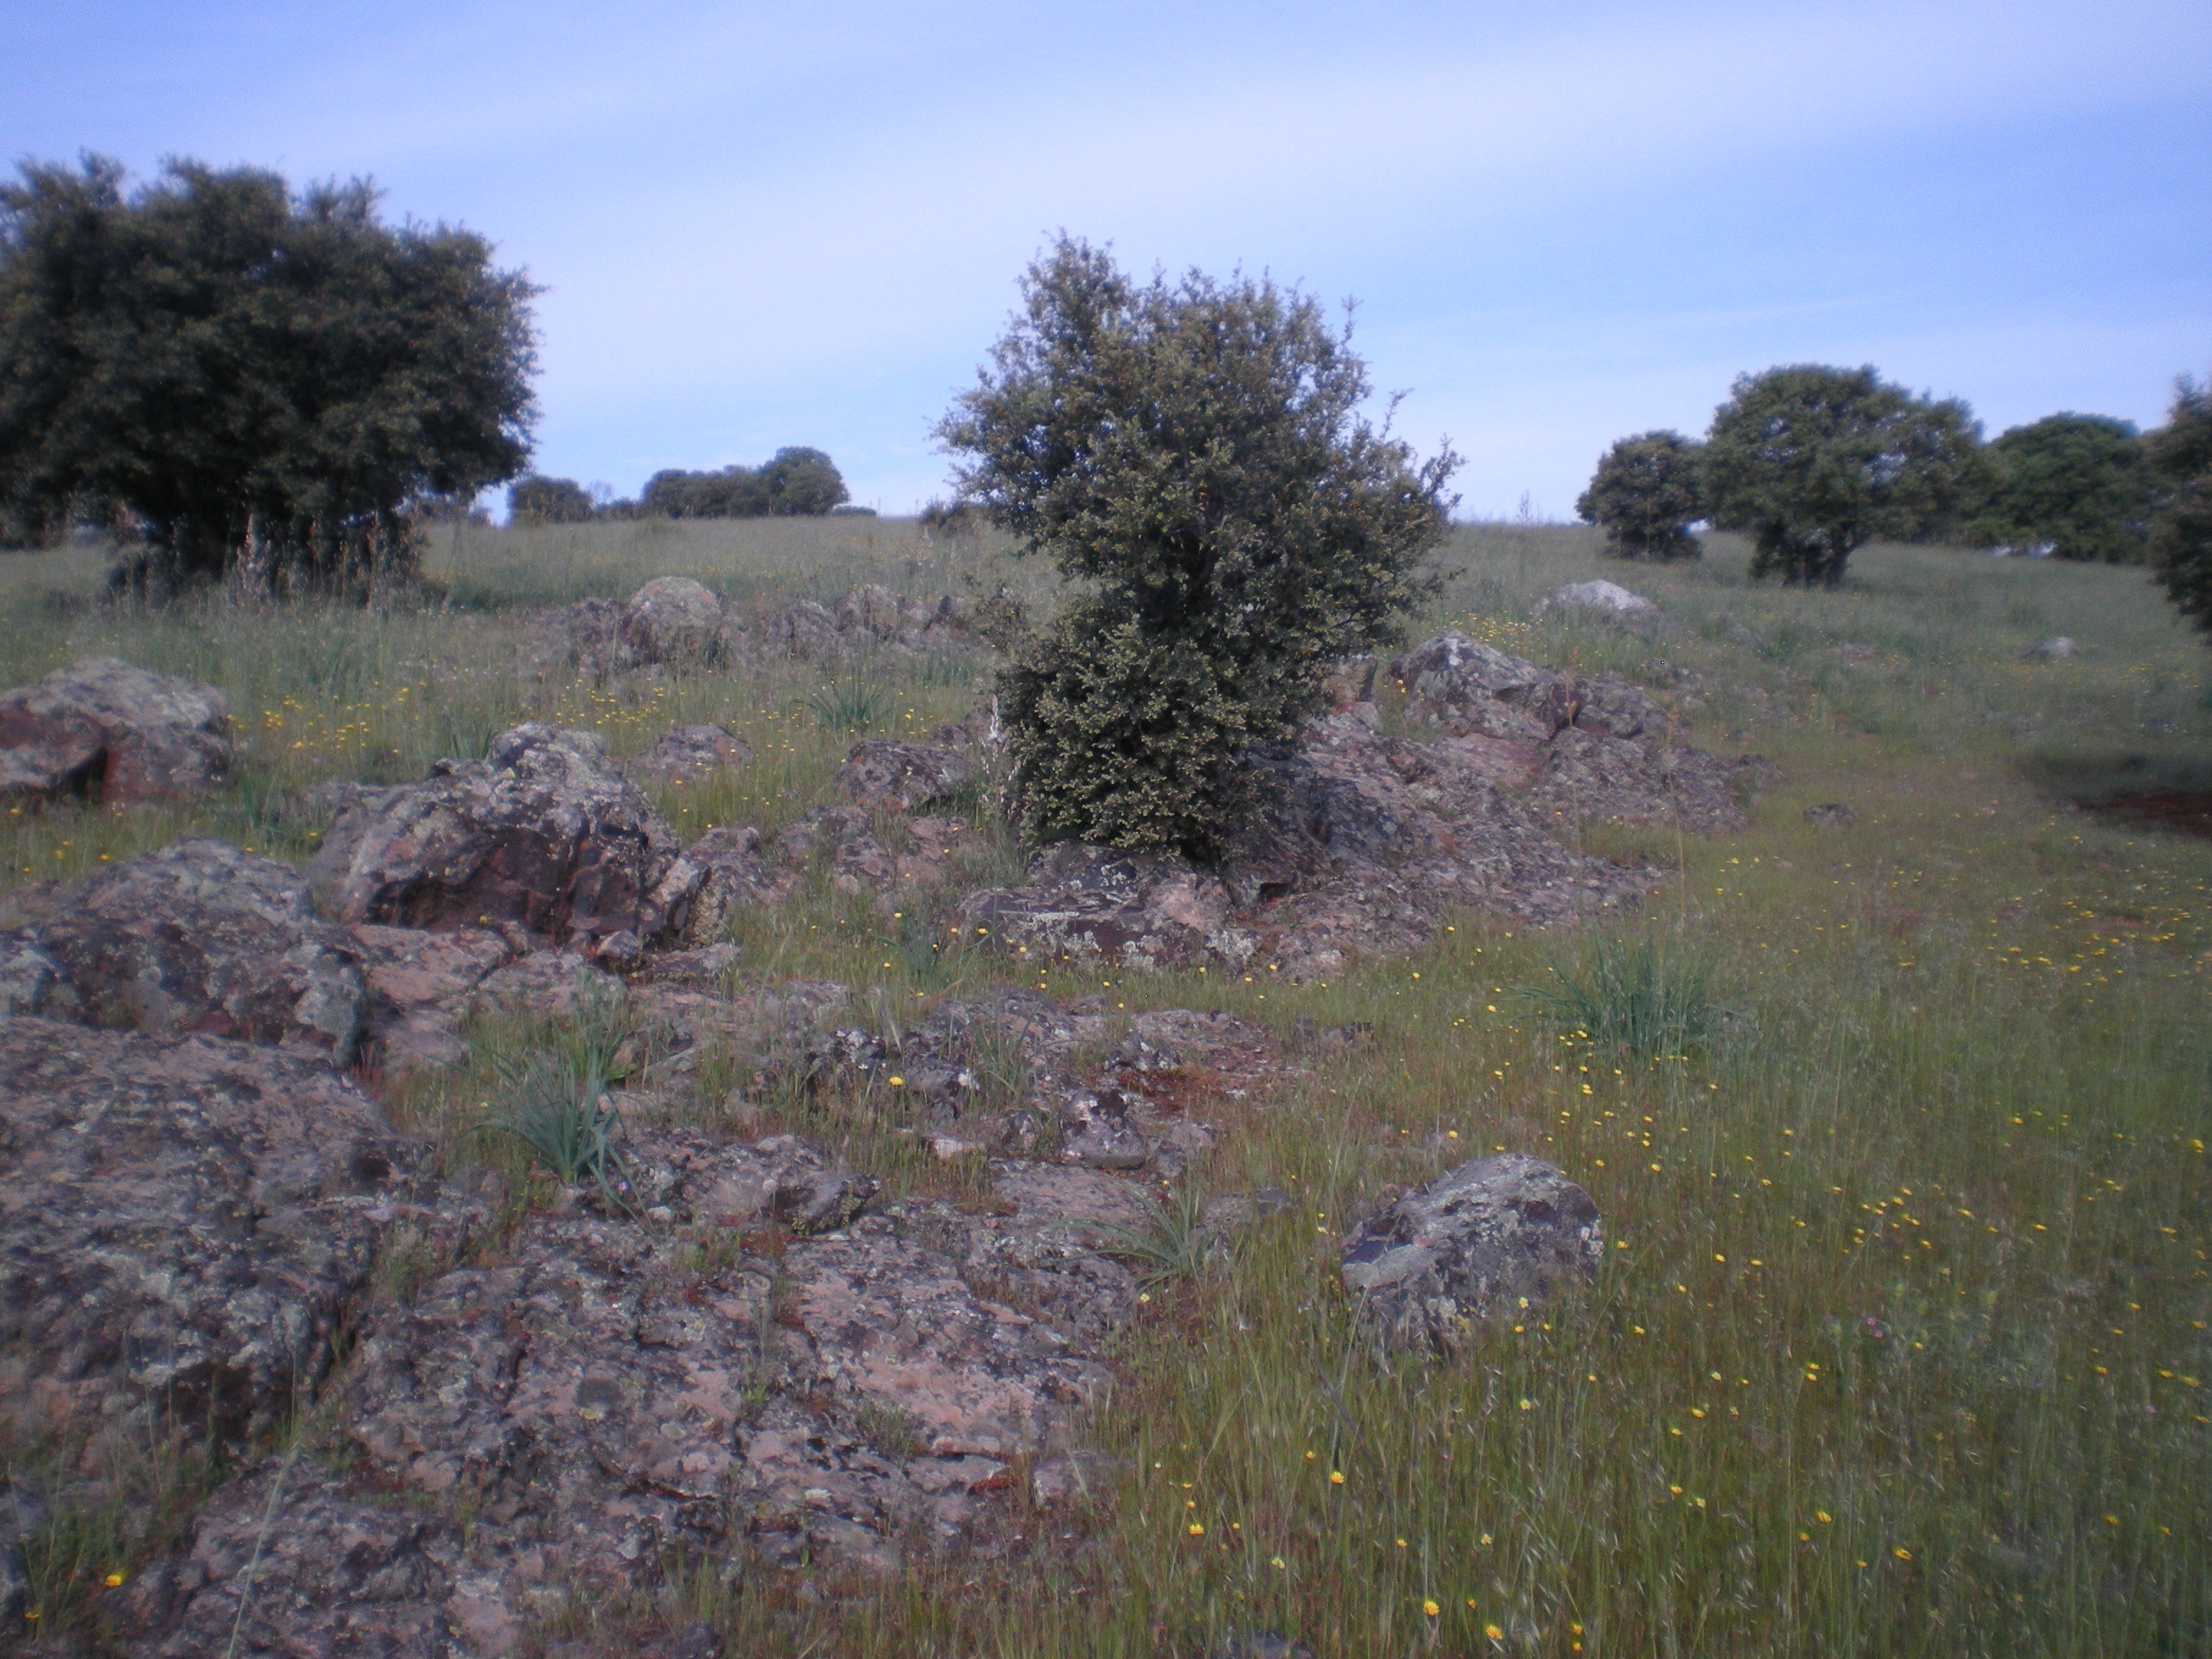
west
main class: Grassland
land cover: Grassland with sparse tree/shrub cover
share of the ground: > 75 %
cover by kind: herbaceous plants 80 %, consolidated bare surface 15 %, broadleaved forest trees 5 %
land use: Agriculture (excluding fallow land and kitchen gardens)
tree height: < 5 m
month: April
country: ES
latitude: 38.7243
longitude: -3.5038
